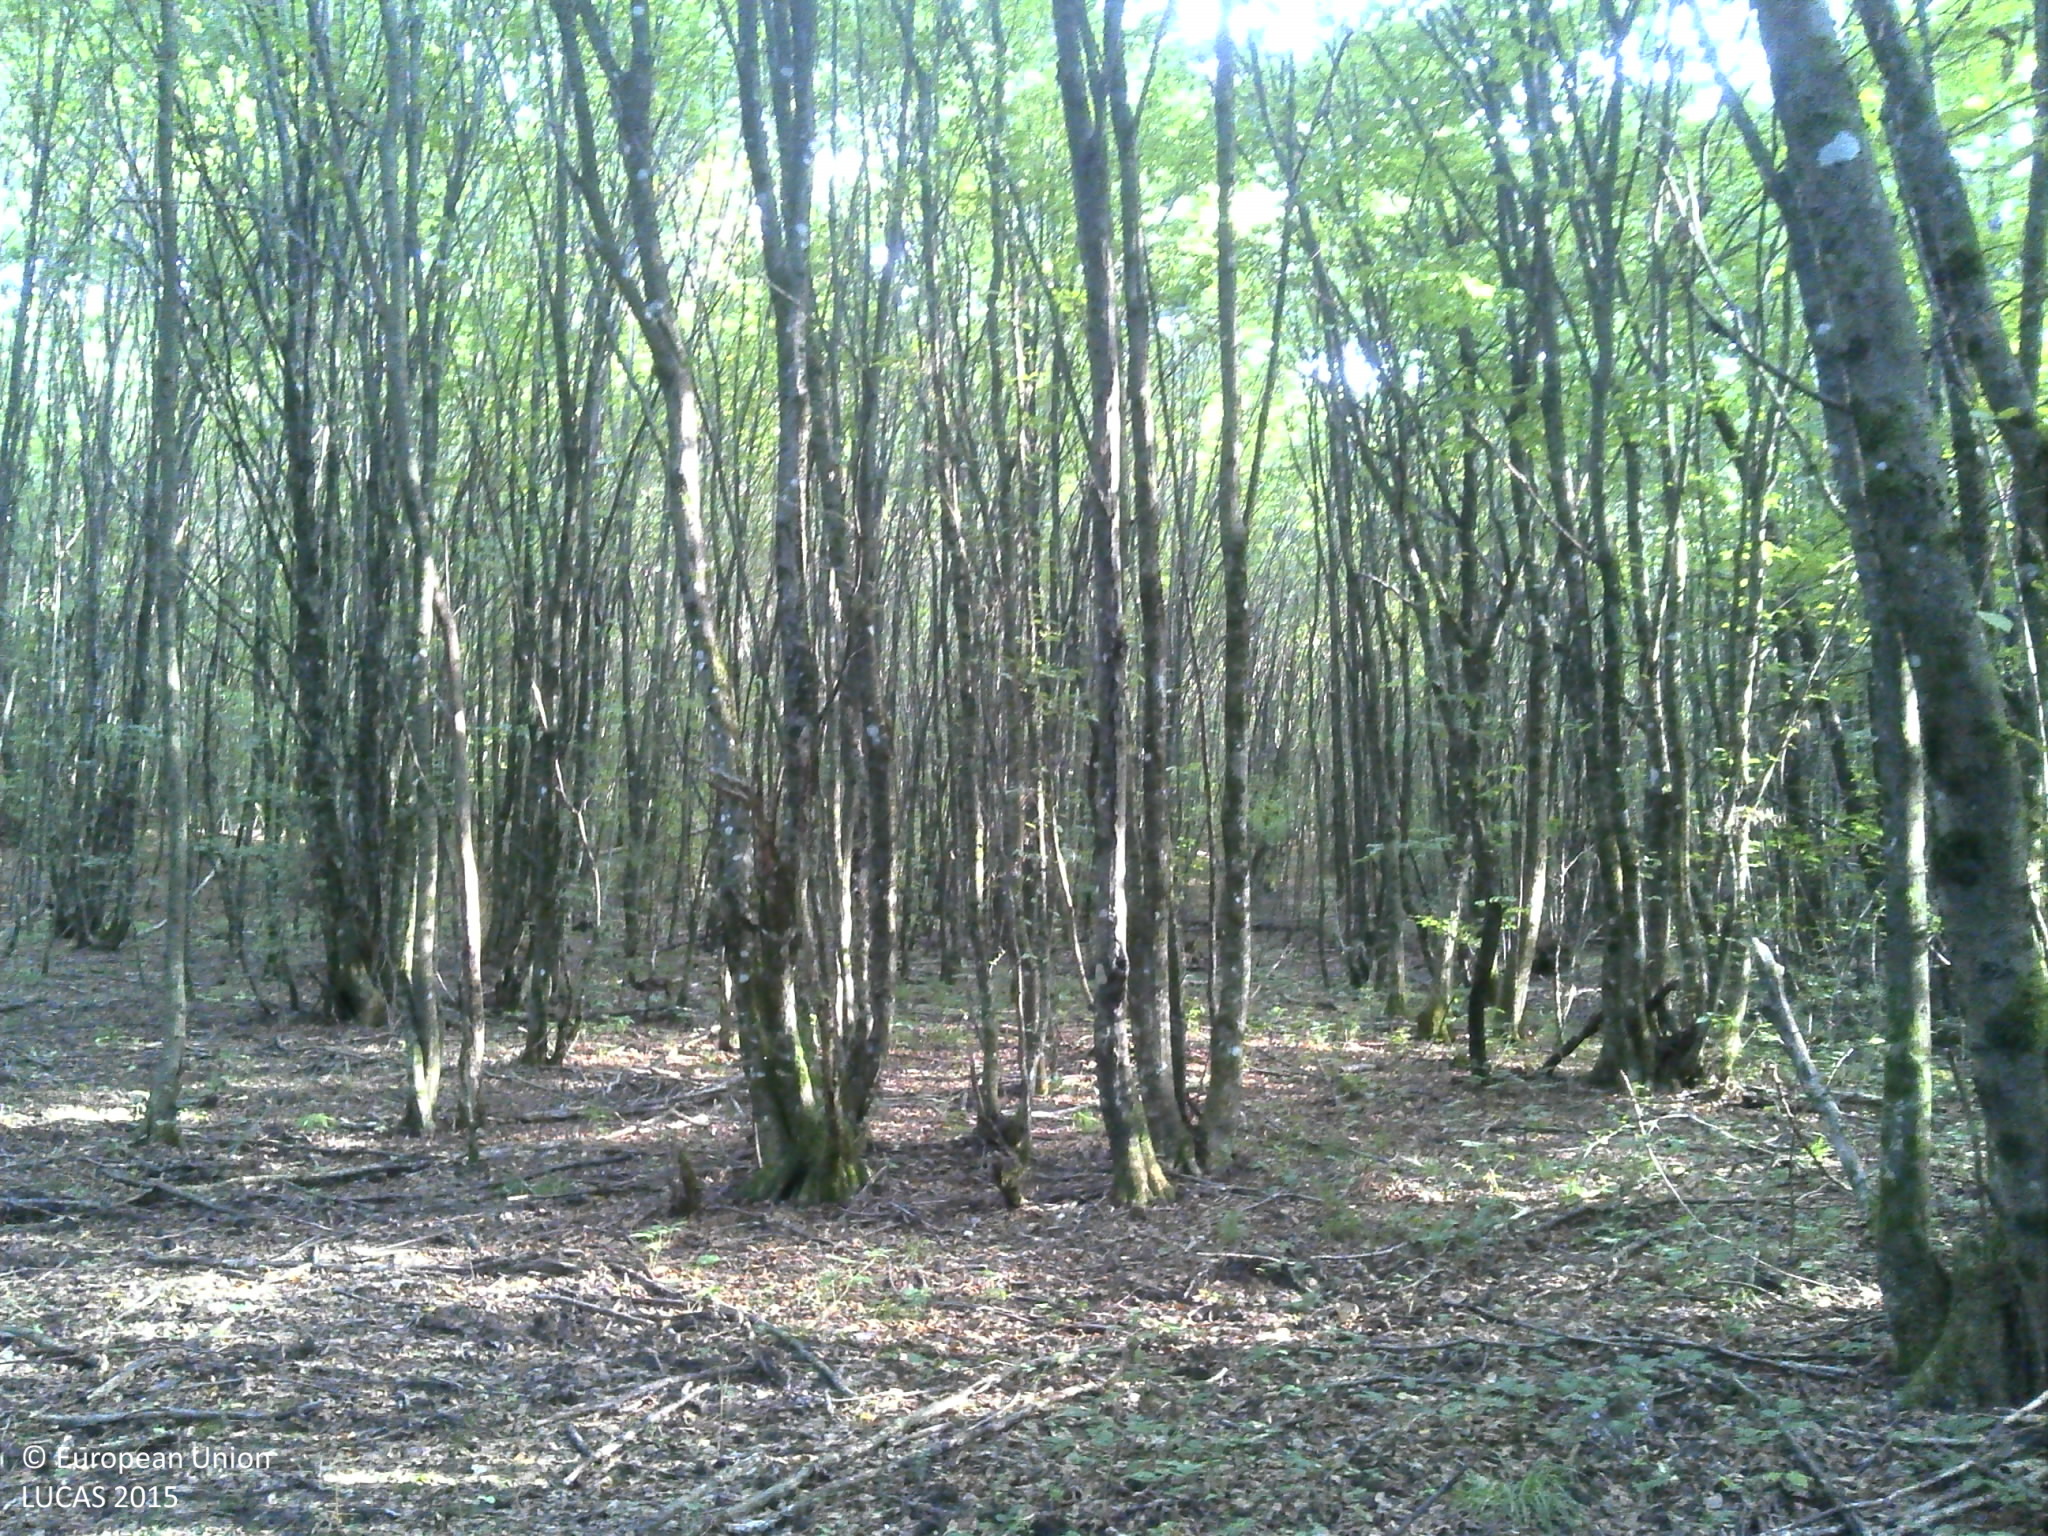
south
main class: Woodland
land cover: Broadleaved woodland
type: acidophilous oak and oak-birch forest
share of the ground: > 75 %
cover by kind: broadleaved forest trees 100 %
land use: Forestry
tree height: > 5 m
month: September
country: HR
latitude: 45.4891
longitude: 16.1262
